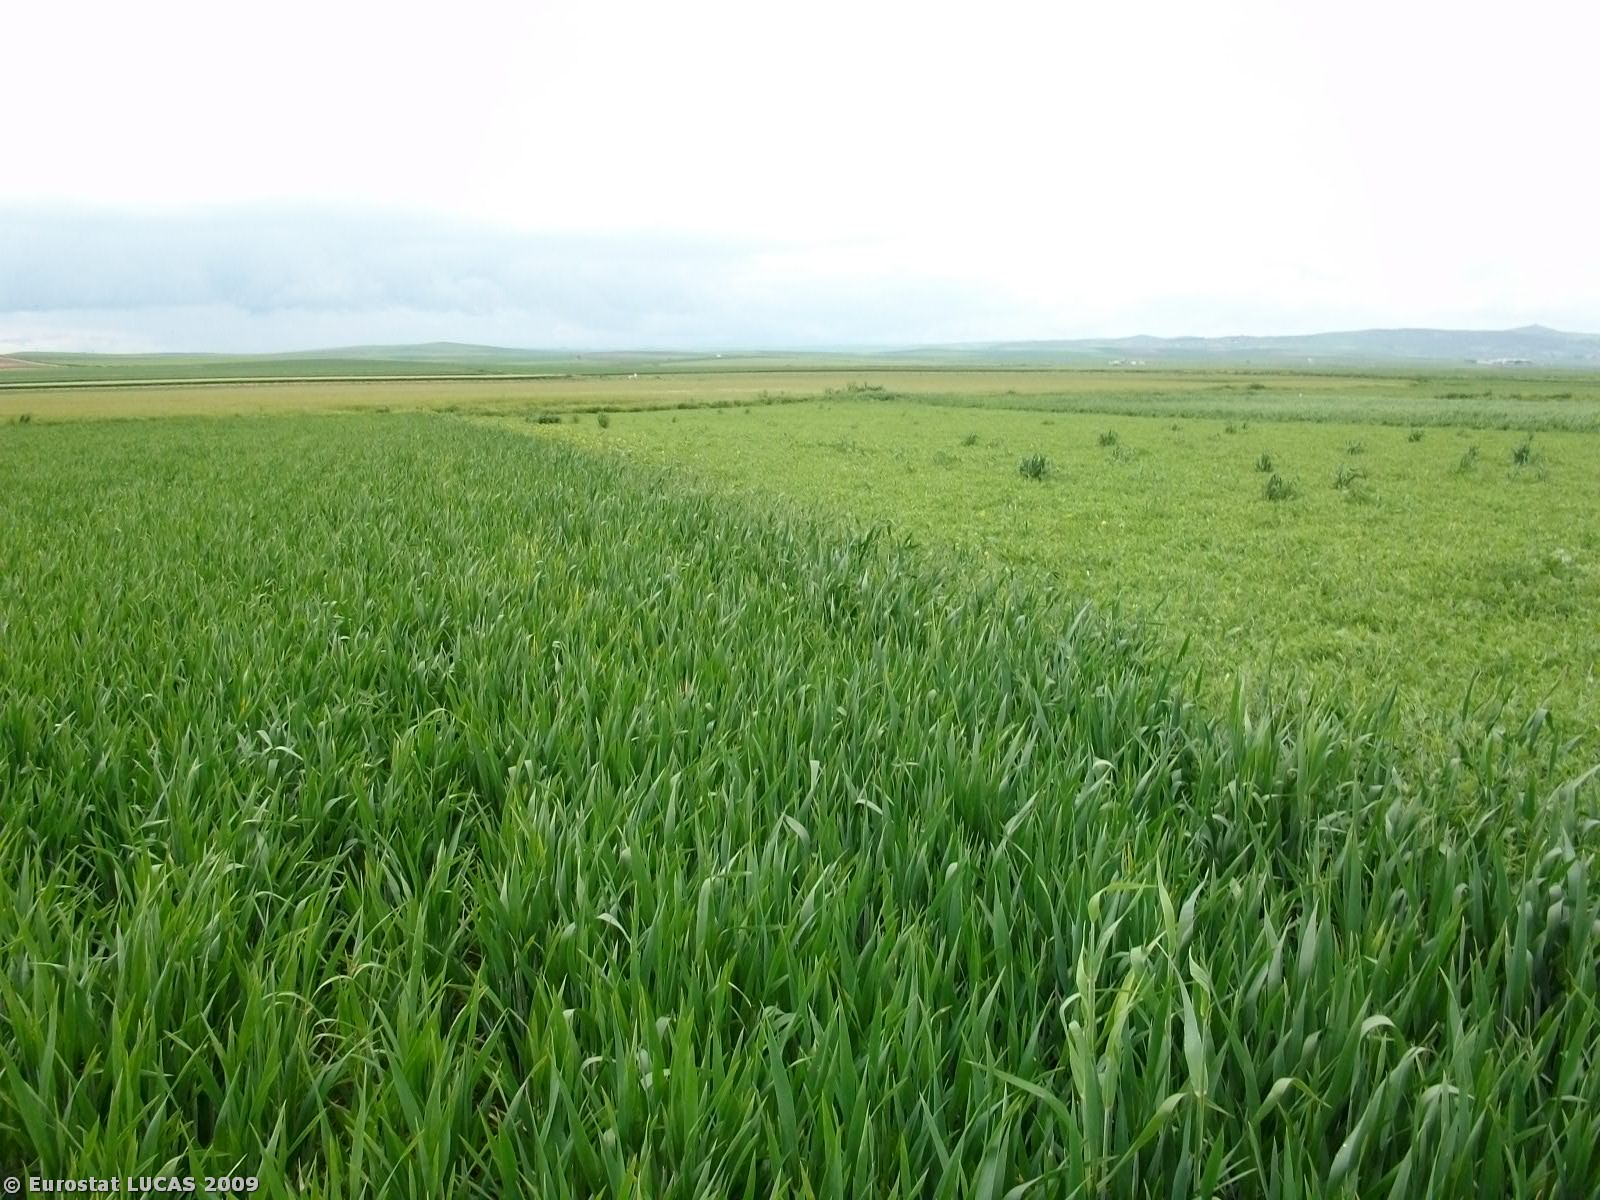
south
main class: Cropland
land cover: Durum wheat
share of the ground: > 75 %
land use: Agriculture (excluding fallow land and kitchen gardens)
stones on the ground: < 10 %
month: April
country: GR
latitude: 39.5171
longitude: 22.3758
